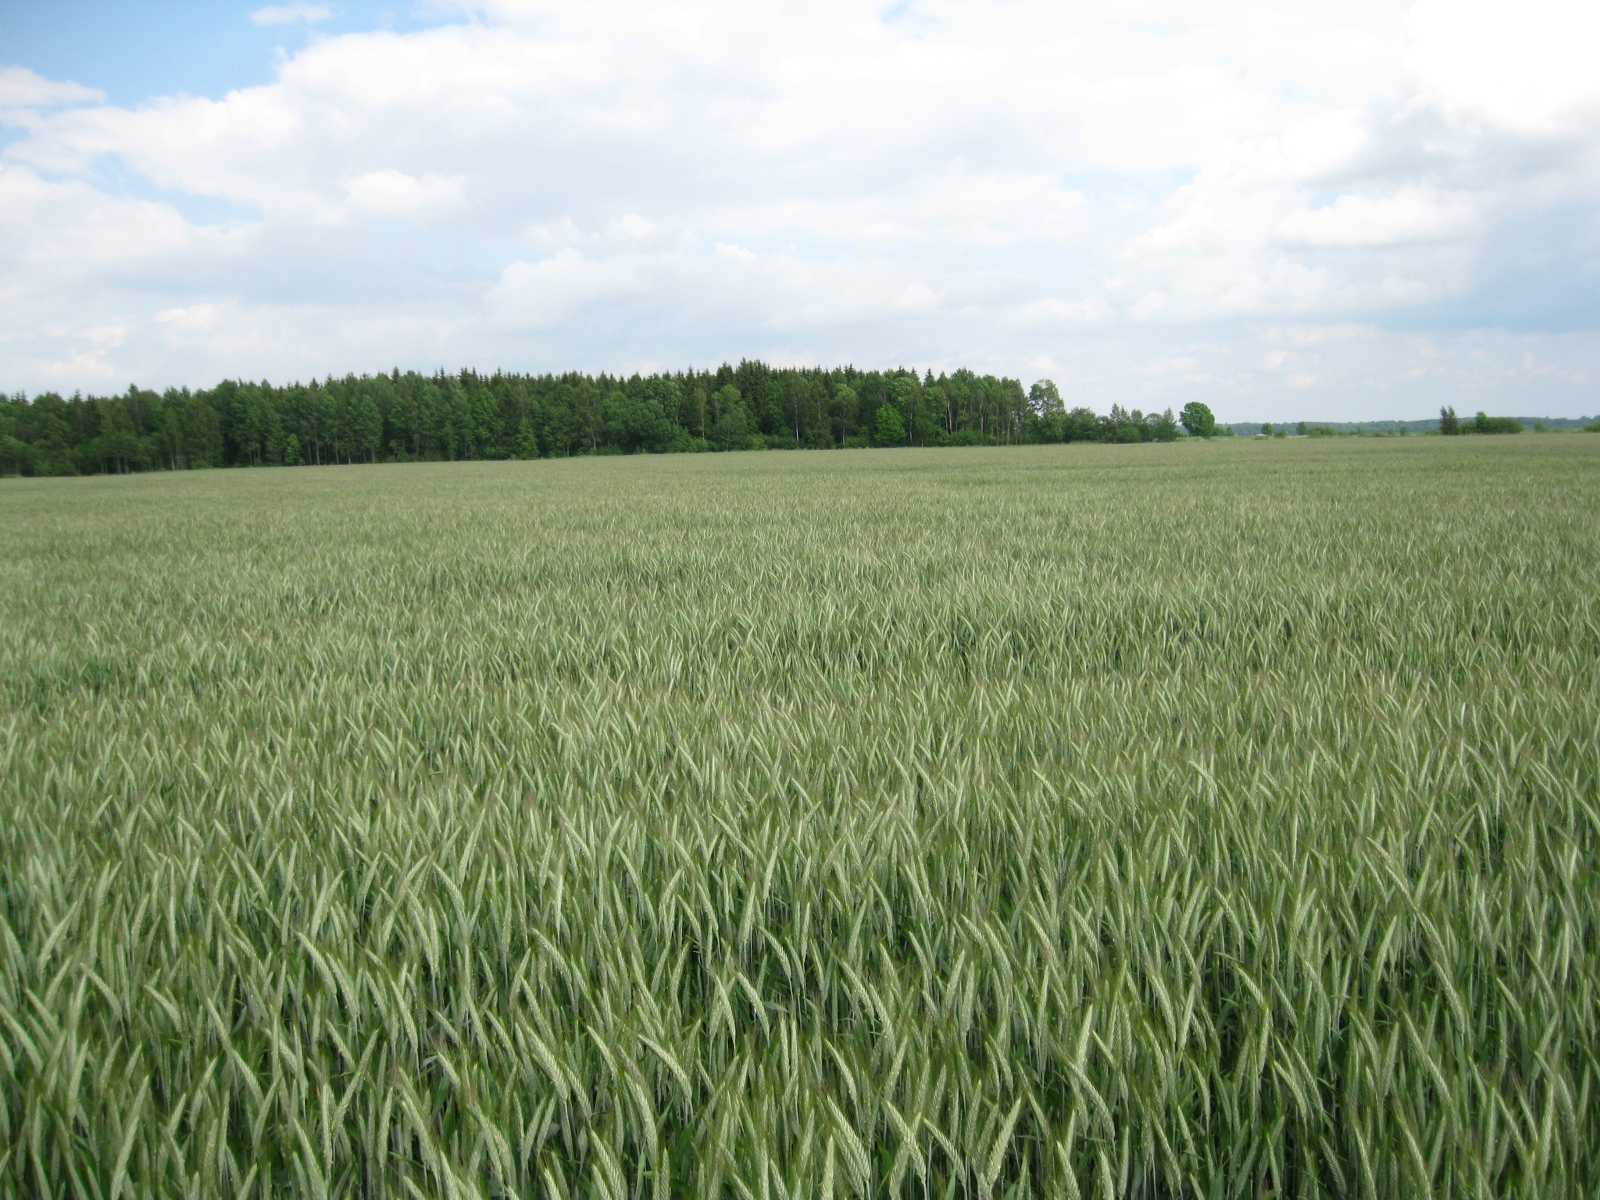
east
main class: Cropland
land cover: Triticale
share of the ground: > 75 %
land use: Agriculture (excluding fallow land and kitchen gardens)
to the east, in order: Triticale
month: June
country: LT
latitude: 55.6074
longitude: 23.9132
